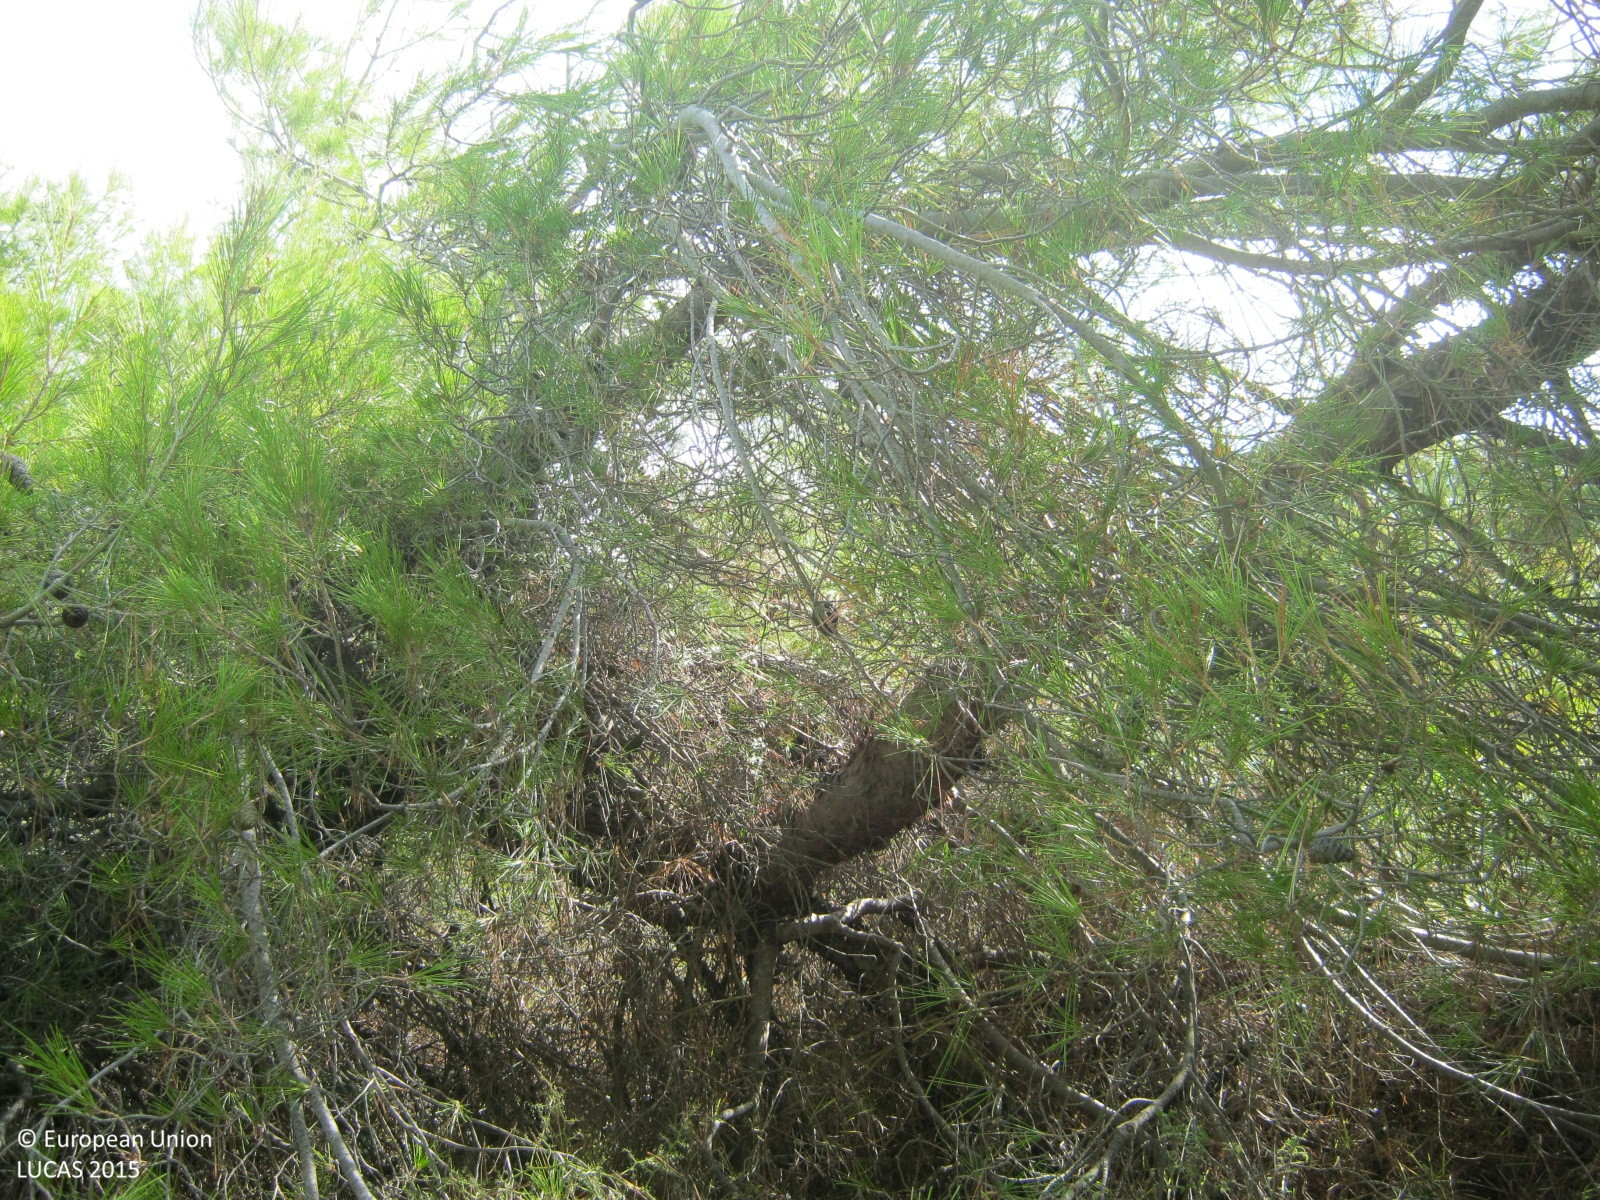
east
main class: Woodland
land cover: Pine dominated coniferous woodland
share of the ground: > 75 %
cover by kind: coniferous forest trees 85 %, shrubs 15 %
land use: Semi-natural and natural areas not in use
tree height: > 5 m
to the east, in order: Pine dominated coniferous woodland; Tracks; Pine dominated coniferous woodland; Olive groves
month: September
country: GR
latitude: 37.8830
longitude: 22.8298
